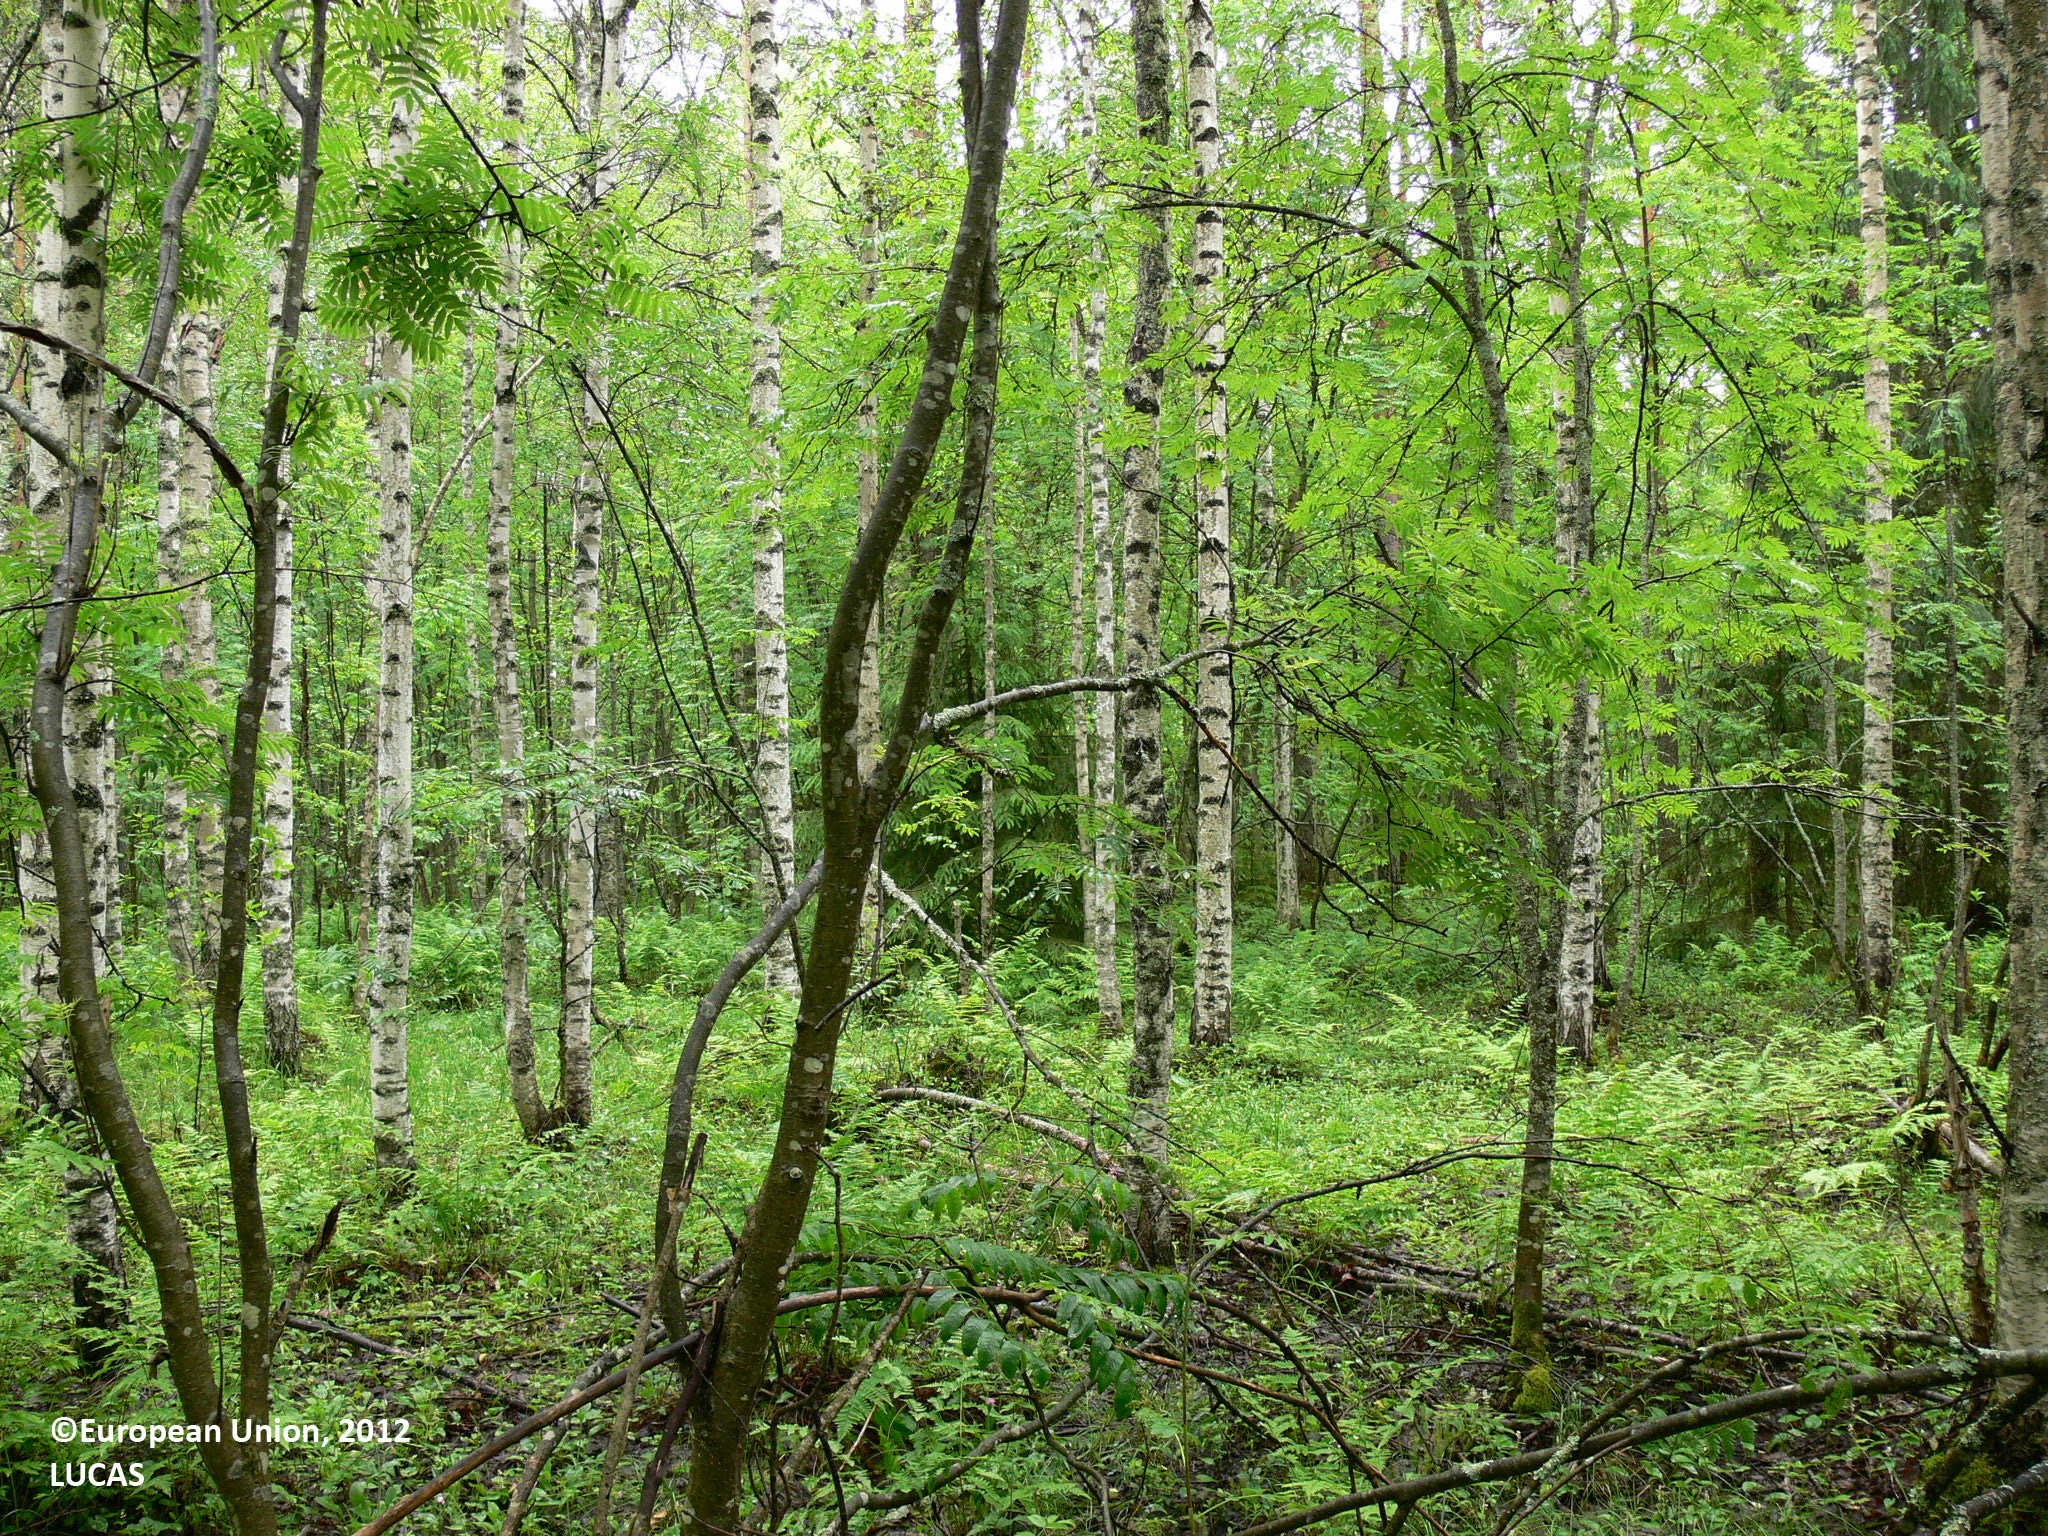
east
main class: Woodland
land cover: Broadleaved woodland
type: boreal forest
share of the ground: > 75 %
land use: Amenities, museums, leisure
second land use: Forestry
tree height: > 5 m
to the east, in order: Broadleaved woodland; Other mixed woodland; Broadleaved woodland; Inland water bodies; Broadleaved woodland; Grass margins; Temporary grasslands; Ditches and canals; Temporary grasslands; Grass margins; Ditches and canals; Shruby margins; Other mixed woodland; Broadleaved woodland
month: June
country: FI
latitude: 62.6197
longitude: 29.6776
